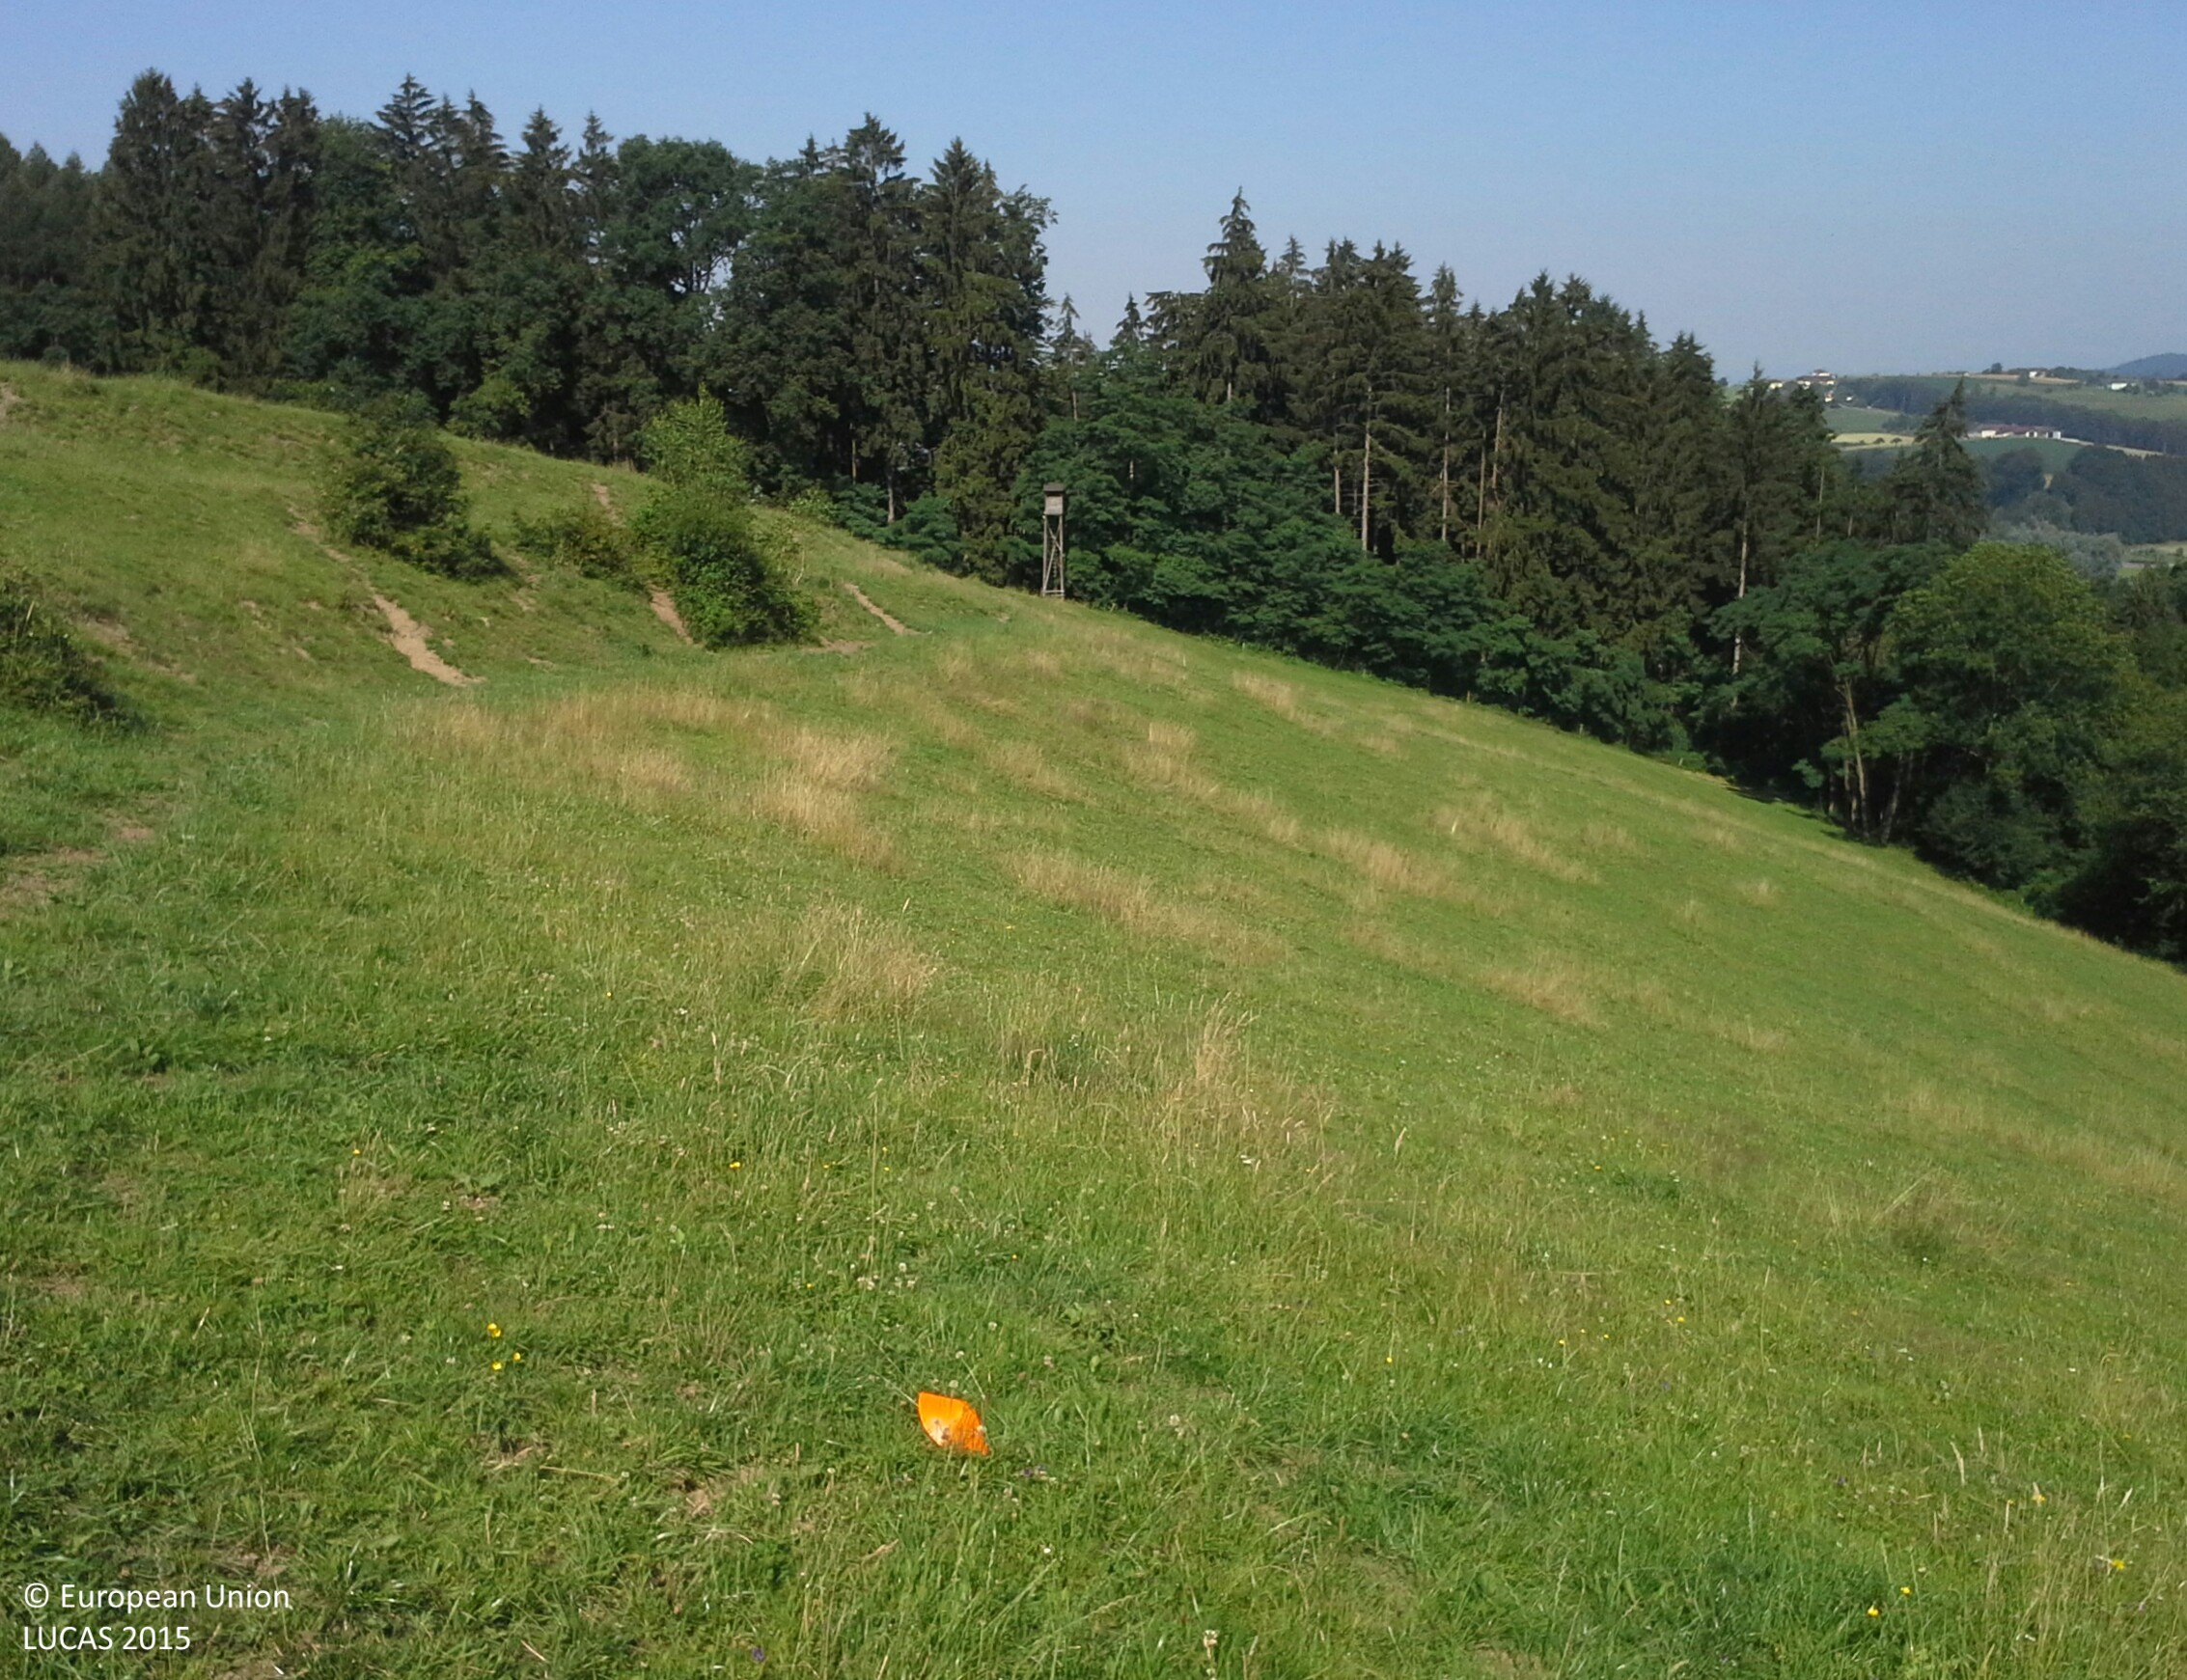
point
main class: Grassland
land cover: Grassland without tree/shrub cover
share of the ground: > 75 %
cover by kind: herbaceous plants 100 %
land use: Agriculture (excluding fallow land and kitchen gardens)
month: July
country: AT
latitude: 48.1887
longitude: 14.8569
